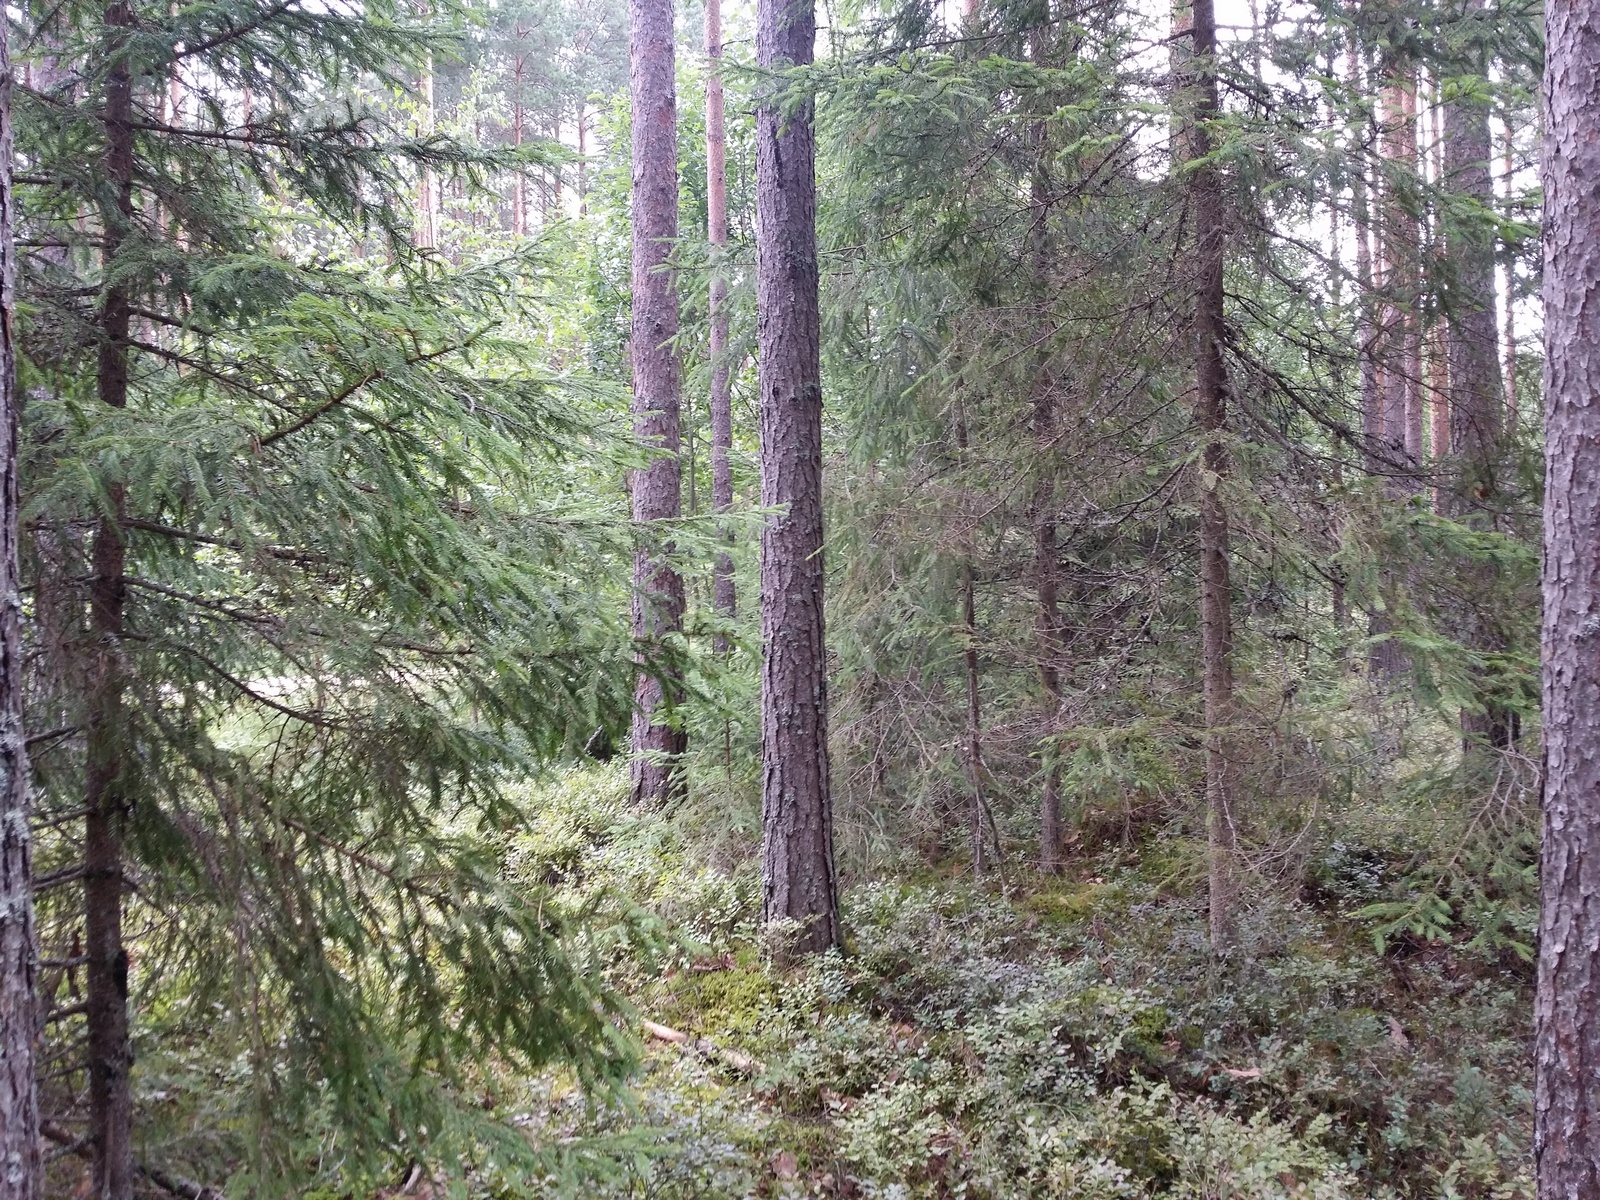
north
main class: Woodland
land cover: Other coniferous woodland
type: hemiboreal forest and nemoral coniferous forest and mixed broadleaved-coniferous forest
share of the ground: > 75 %
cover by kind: coniferous forest trees 85 %, lichens and mosses 15 %
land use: Forestry
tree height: > 5 m
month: August
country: LV
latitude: 57.2580
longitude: 26.6771
